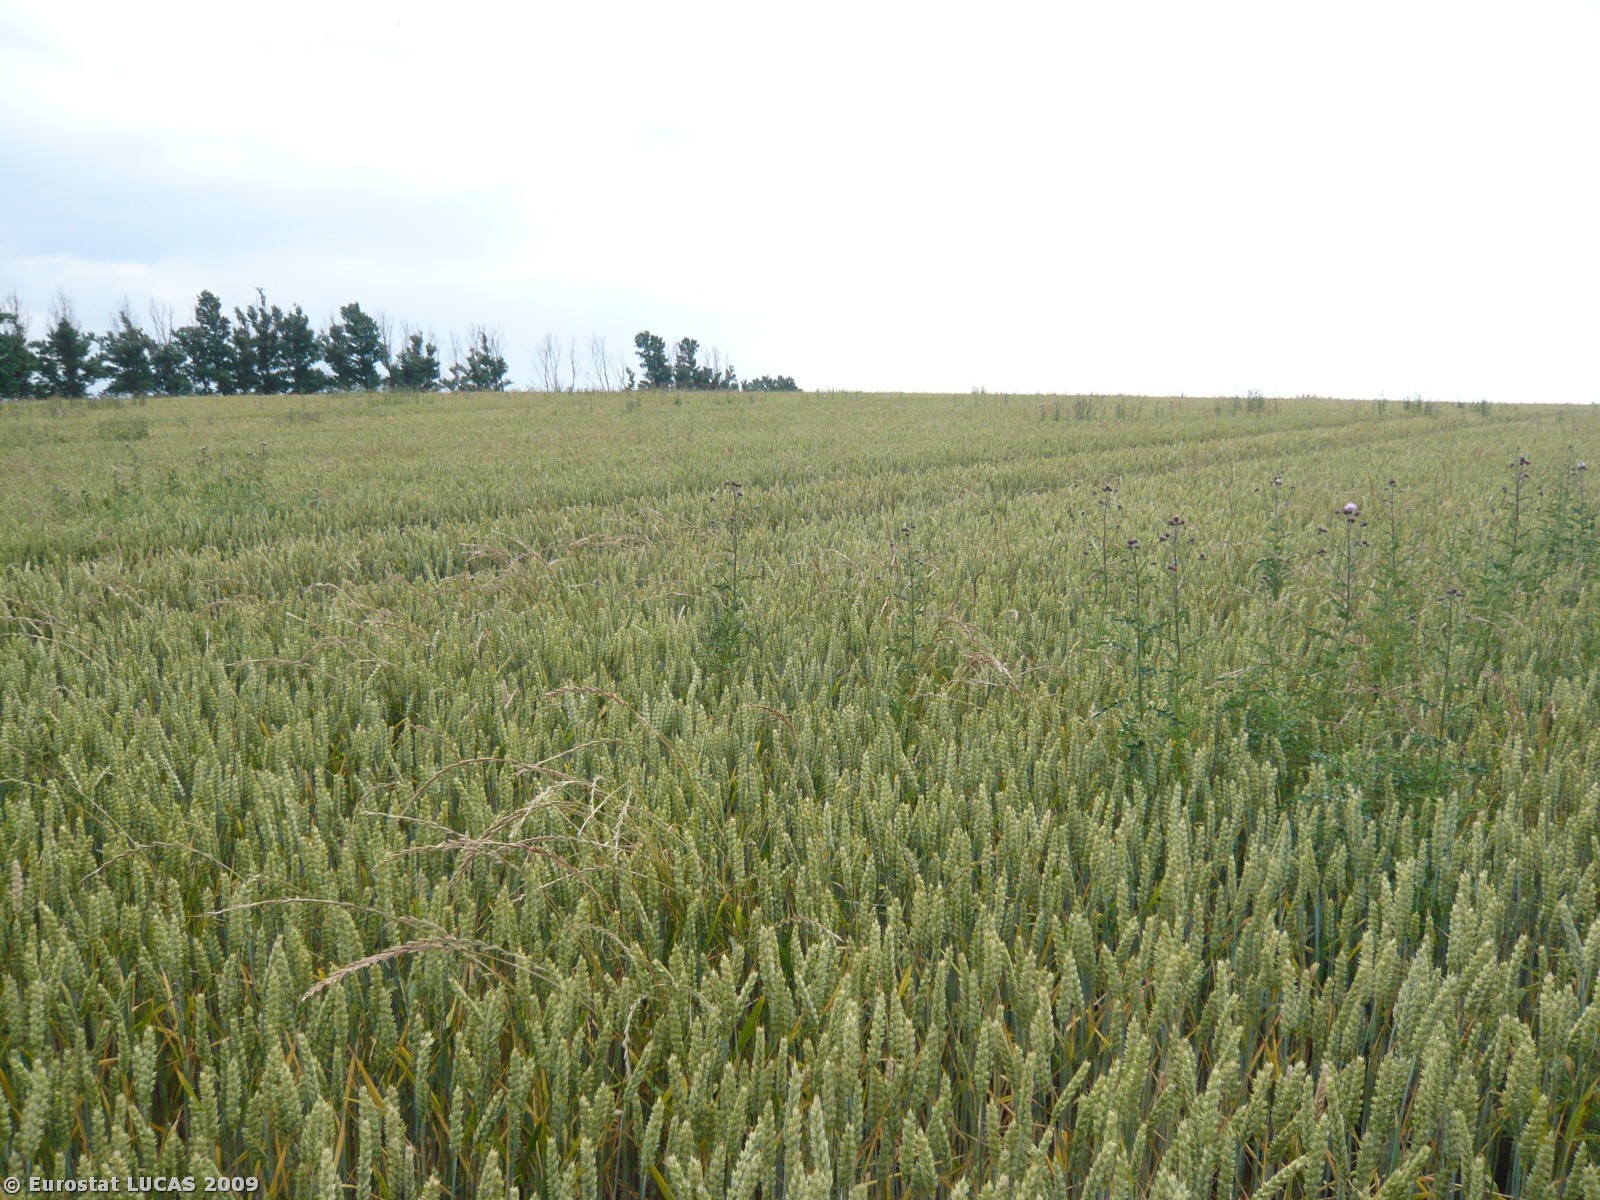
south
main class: Cropland
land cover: Common wheat
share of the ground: > 75 %
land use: Agriculture (excluding fallow land and kitchen gardens)
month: July
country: DK
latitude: 55.5226
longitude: 10.1424
